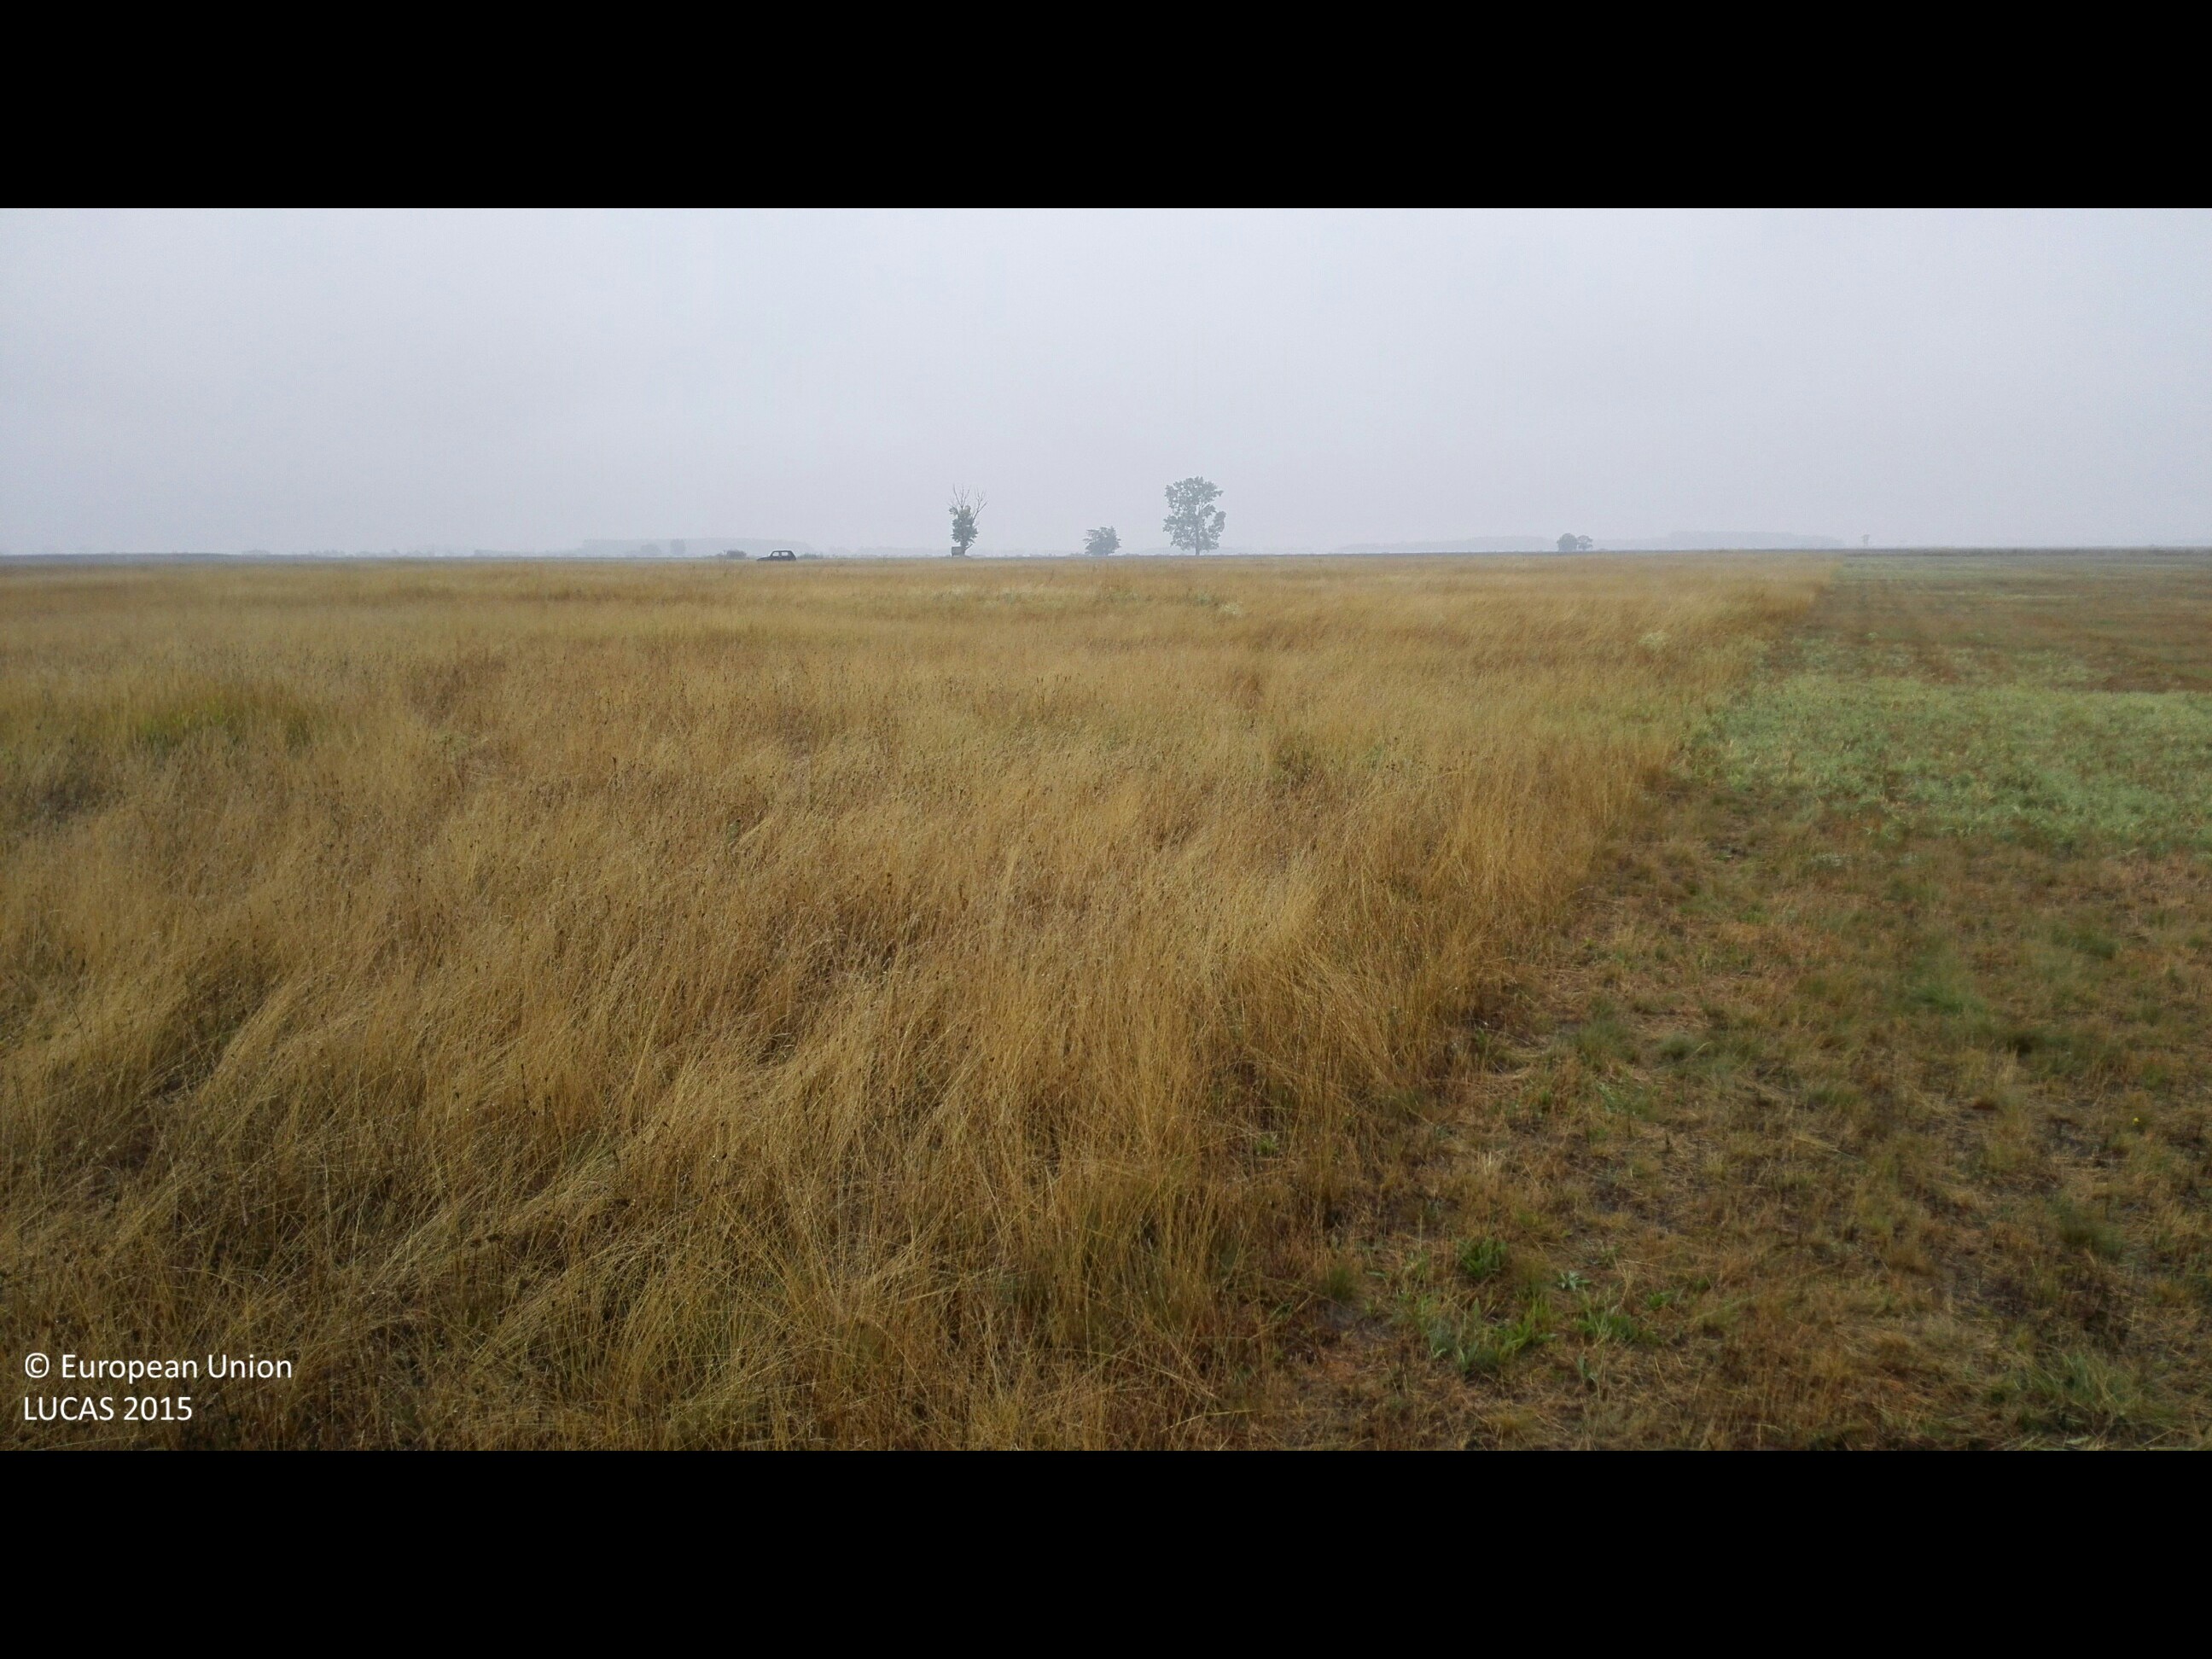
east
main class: Grassland
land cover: Grassland without tree/shrub cover
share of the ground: > 75 %
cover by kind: herbaceous plants 100 %
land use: Agriculture (excluding fallow land and kitchen gardens)
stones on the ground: < 10 %
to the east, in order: Grassland without tree/shrub cover; Tracks; Grassland without tree/shrub cover
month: August
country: HU
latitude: 47.1767
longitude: 21.5609
